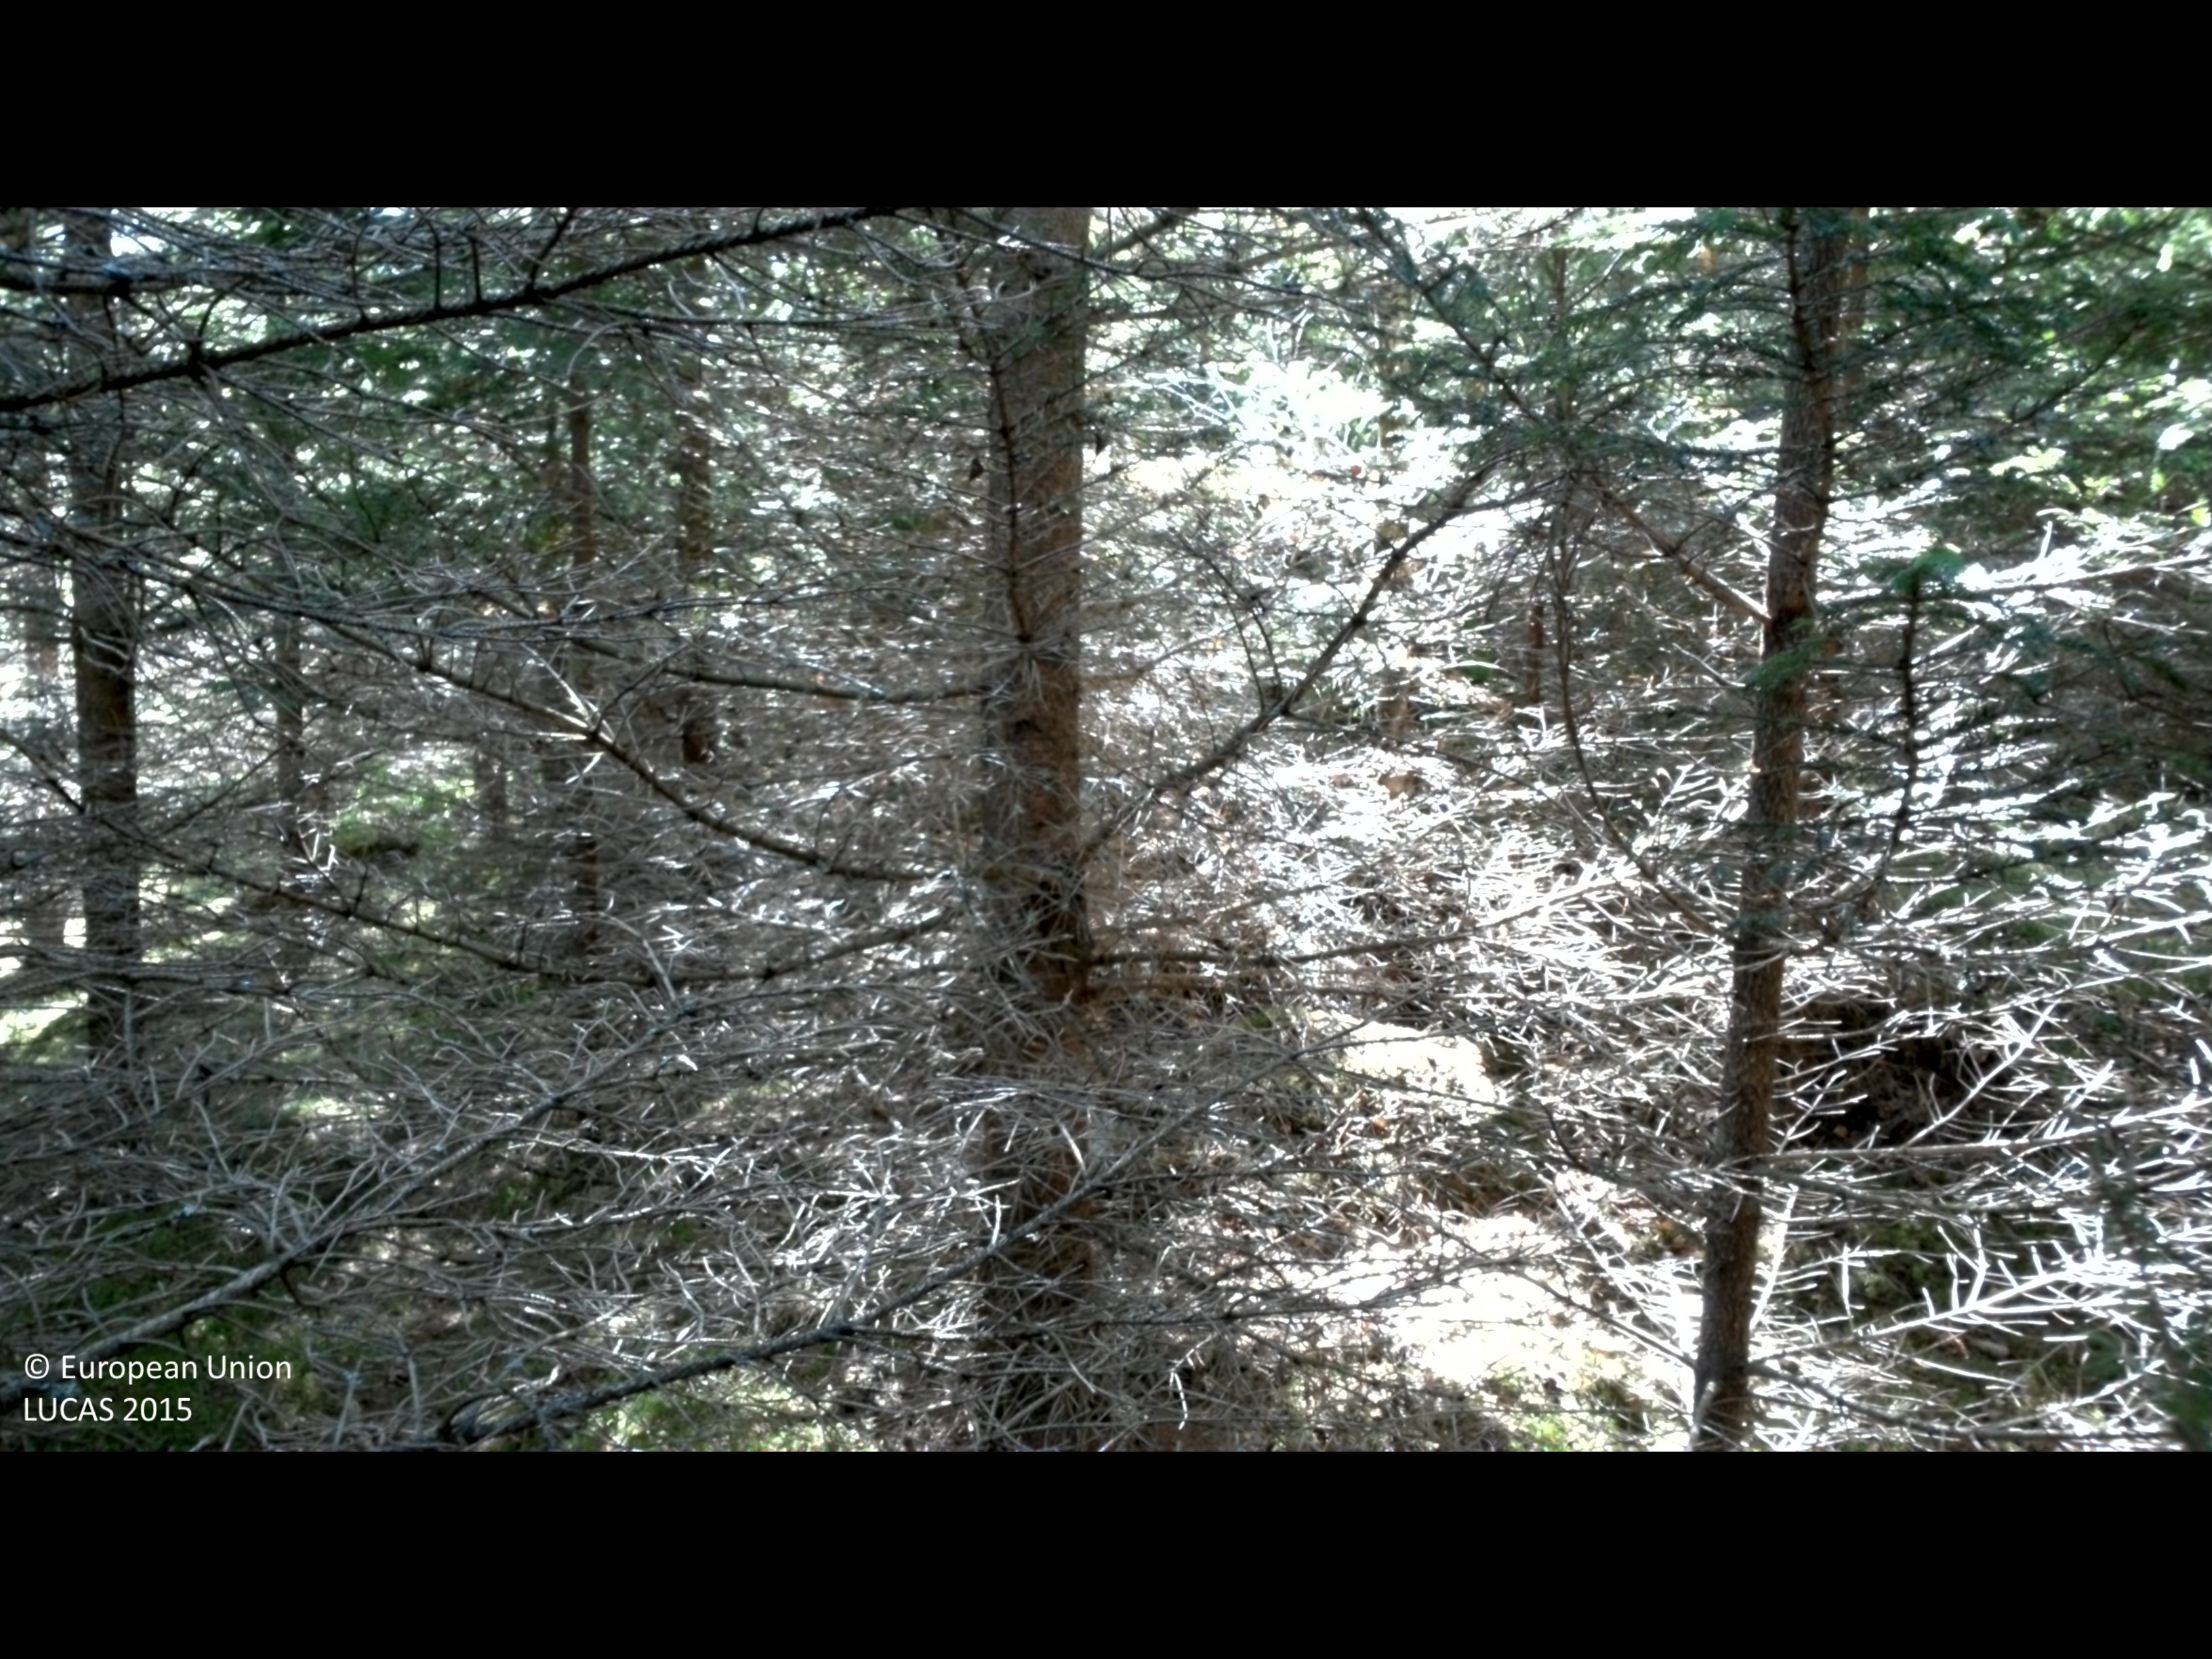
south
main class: Woodland
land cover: Spruce dominated coniferous woodland
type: boreal forest
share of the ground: > 75 %
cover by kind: coniferous forest trees 85 %, lichens and mosses 10 %, broadleaved forest trees 5 %
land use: Forestry
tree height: > 5 m
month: August
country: SE
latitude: 56.3536
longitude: 14.7072
